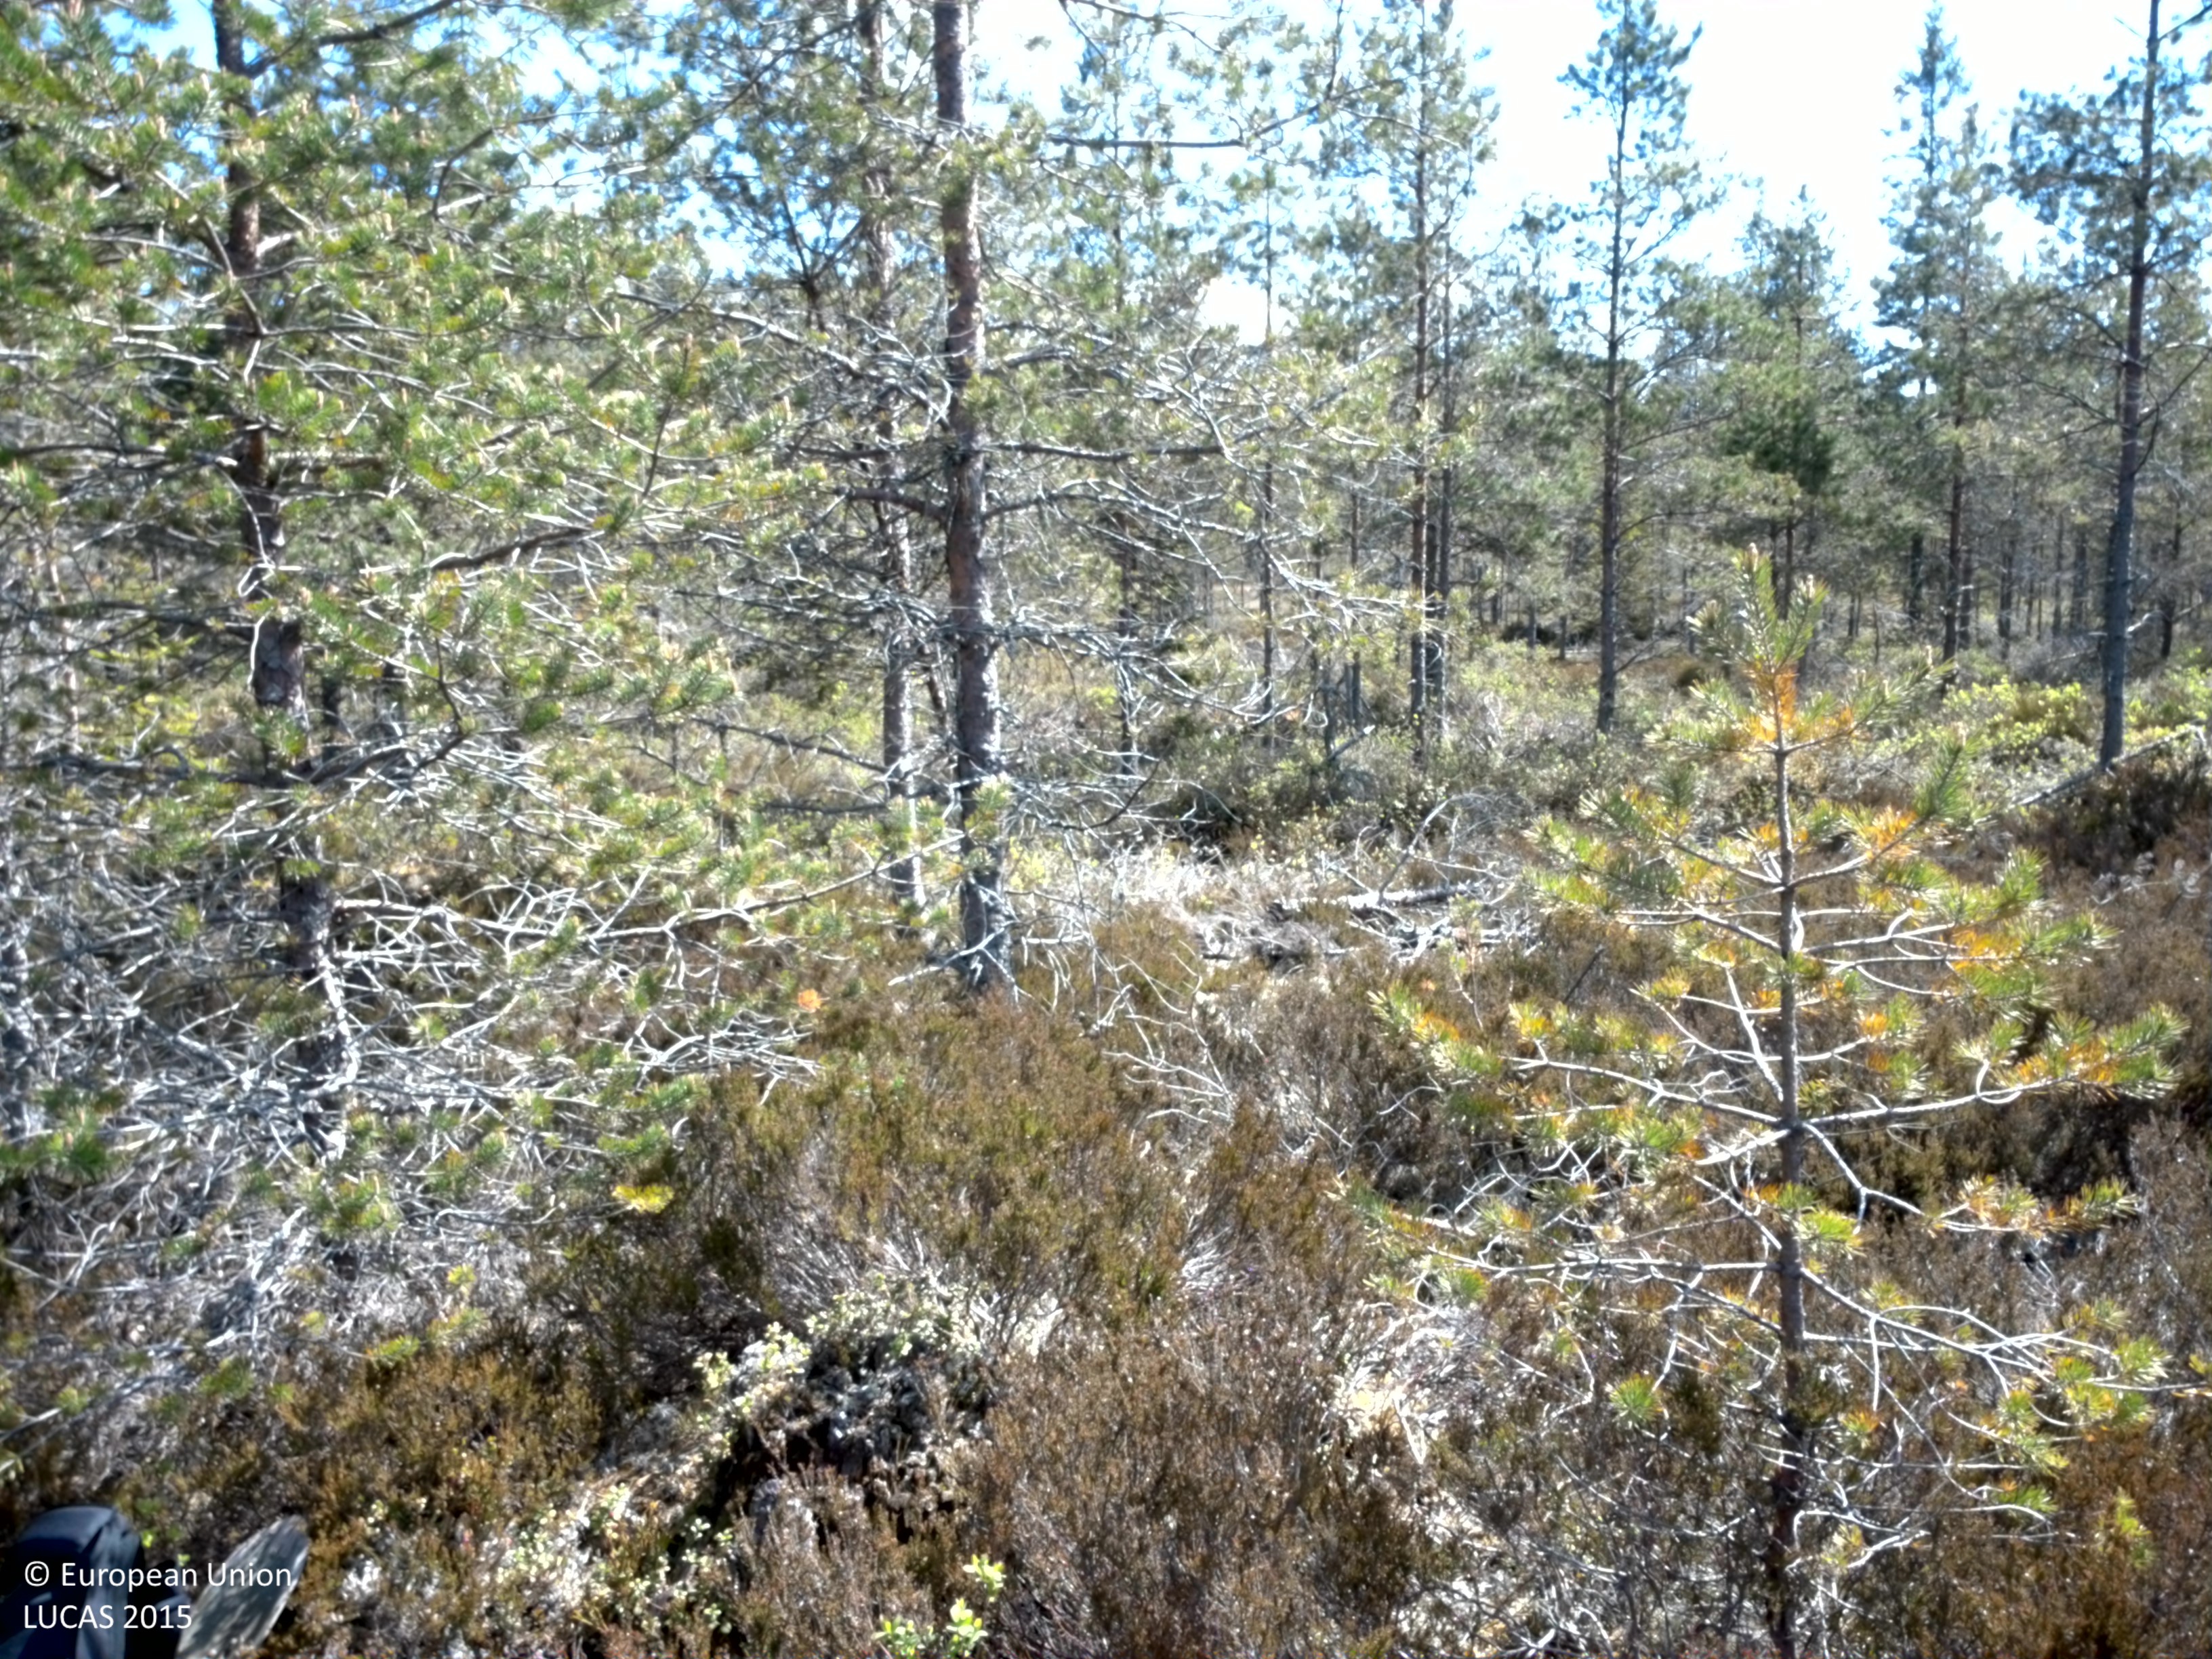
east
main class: Woodland
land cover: Pine dominated coniferous woodland
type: boreal forest
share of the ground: 50 - 75 %
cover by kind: coniferous forest trees 60 %, shrubs 25 %, lichens and mosses 15 %
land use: Forestry
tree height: < 5 m
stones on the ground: 10 - 25 %
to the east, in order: Pine dominated coniferous woodland; Inland marshes; Inland fresh water bodies; Spruce dominated mixed woodland
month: June
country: SE
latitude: 59.4224
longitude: 12.3732
